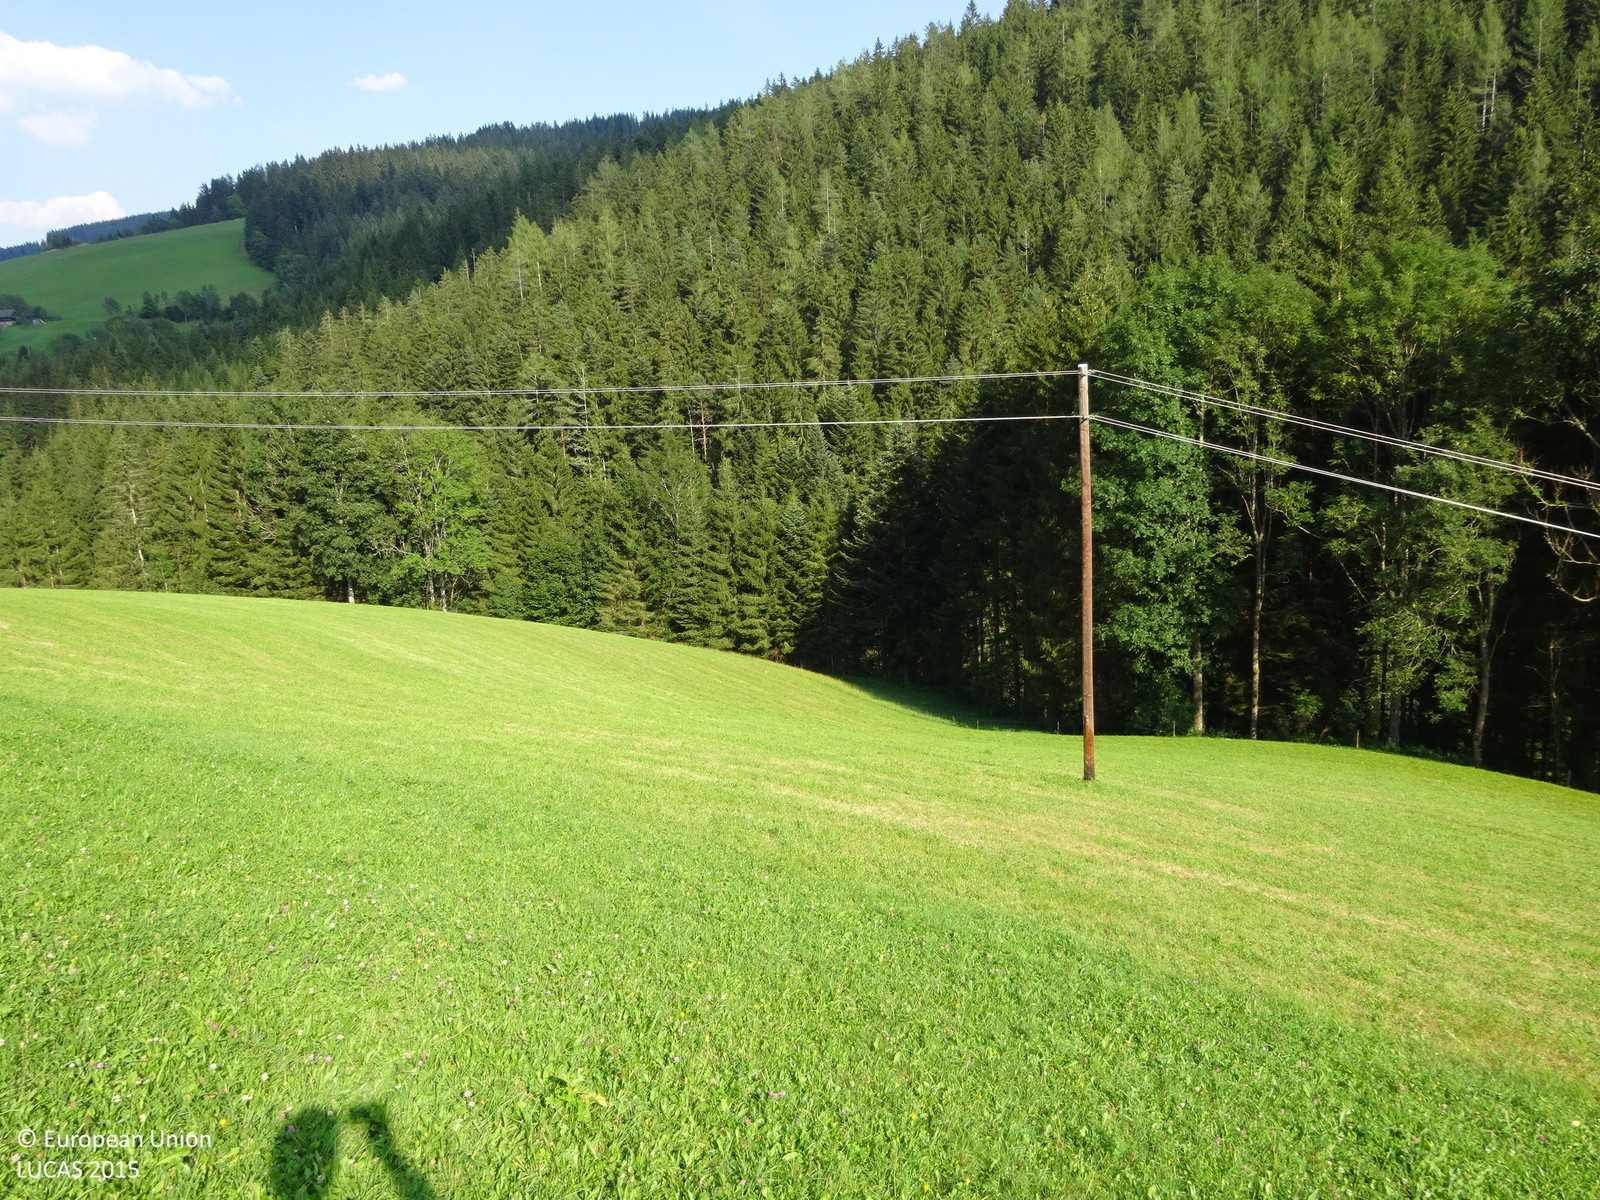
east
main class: Grassland
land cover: Grassland without tree/shrub cover
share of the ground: > 75 %
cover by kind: herbaceous plants 100 %
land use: Agriculture (excluding fallow land and kitchen gardens)
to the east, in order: Grassland without tree/shrub cover; Electric lines; Grassland without tree/shrub cover; Fences; Grassland without tree/shrub cover; Fences; Grassland without tree/shrub cover; Fences; Spruce dominated coniferous woodland; Paved roads, cycling and walking lanes; Grassland without tree/shrub cover; Broadleaved woodland; Inland fresh running water; Spruce dominated mixed woodland; Tracks; Spruce dominated coniferous woodland
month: August
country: AT
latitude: 47.4962
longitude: 15.7493
